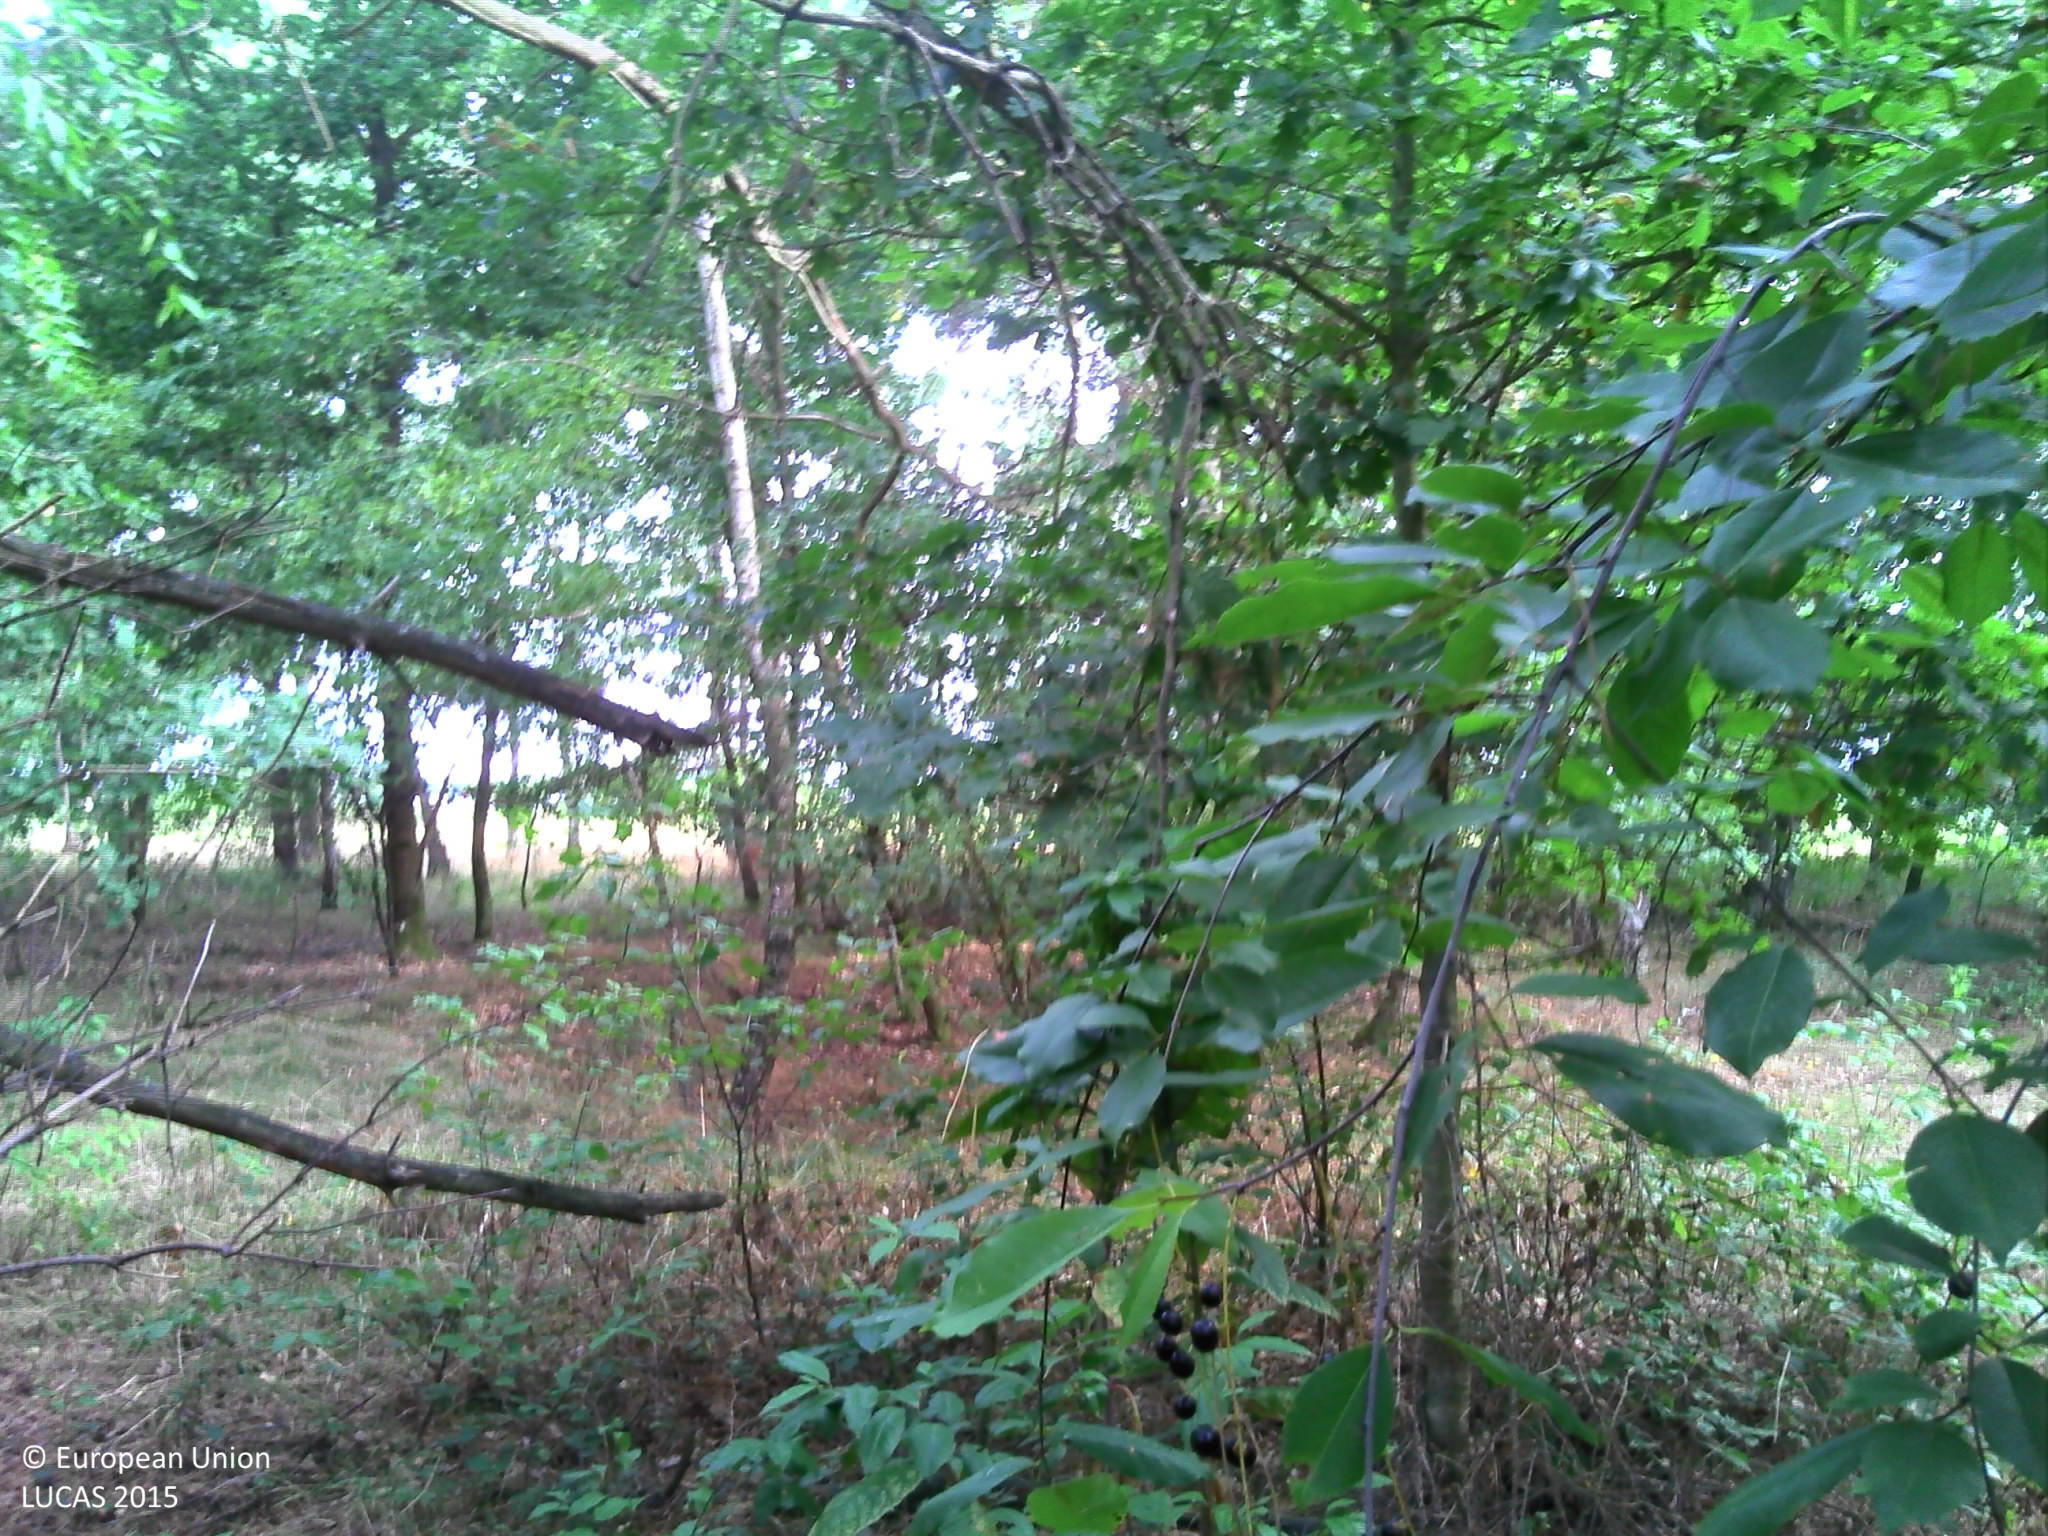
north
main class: Woodland
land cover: Pine dominated mixed woodland
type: hemiboreal forest and nemoral coniferous forest and mixed broadleaved-coniferous forest
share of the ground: > 75 %
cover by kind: broadleaved forest trees 50 %, coniferous forest trees 35 %, herbaceous plants 15 %
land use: Forestry
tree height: > 5 m
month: August
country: FR
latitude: 48.7042
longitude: 7.7315
